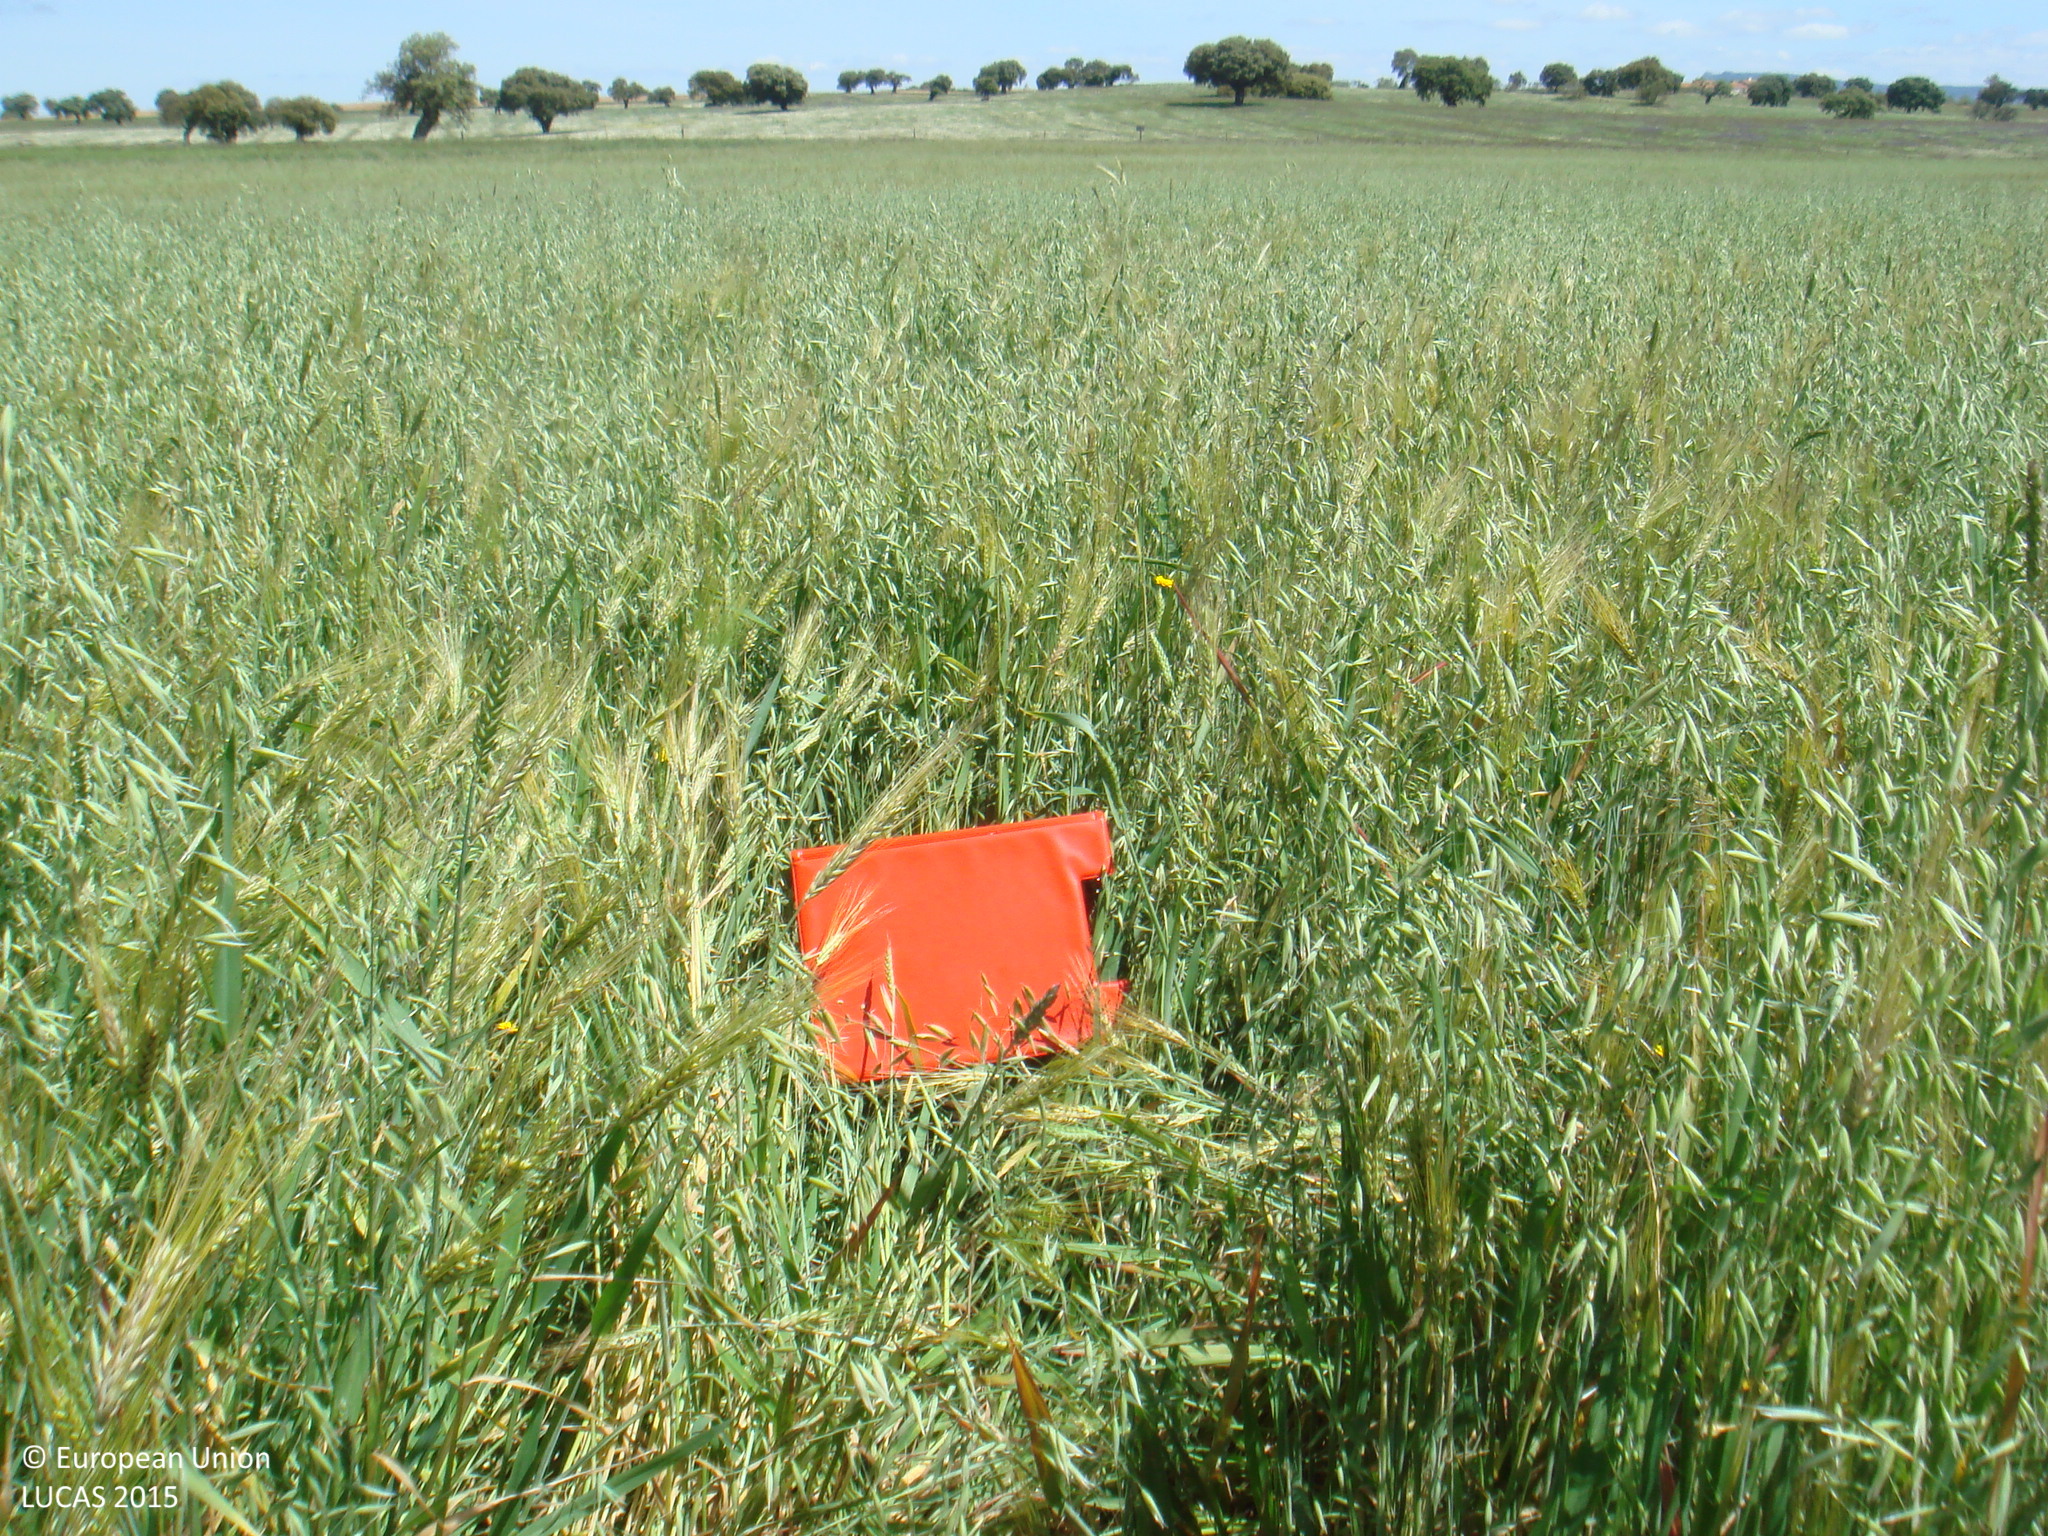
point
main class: Cropland
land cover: Mixed cereals for fodder
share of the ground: > 75 %
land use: Agriculture (excluding fallow land and kitchen gardens)
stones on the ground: 10 - 25 %
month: April
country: ES
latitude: 38.5088
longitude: -5.0630
